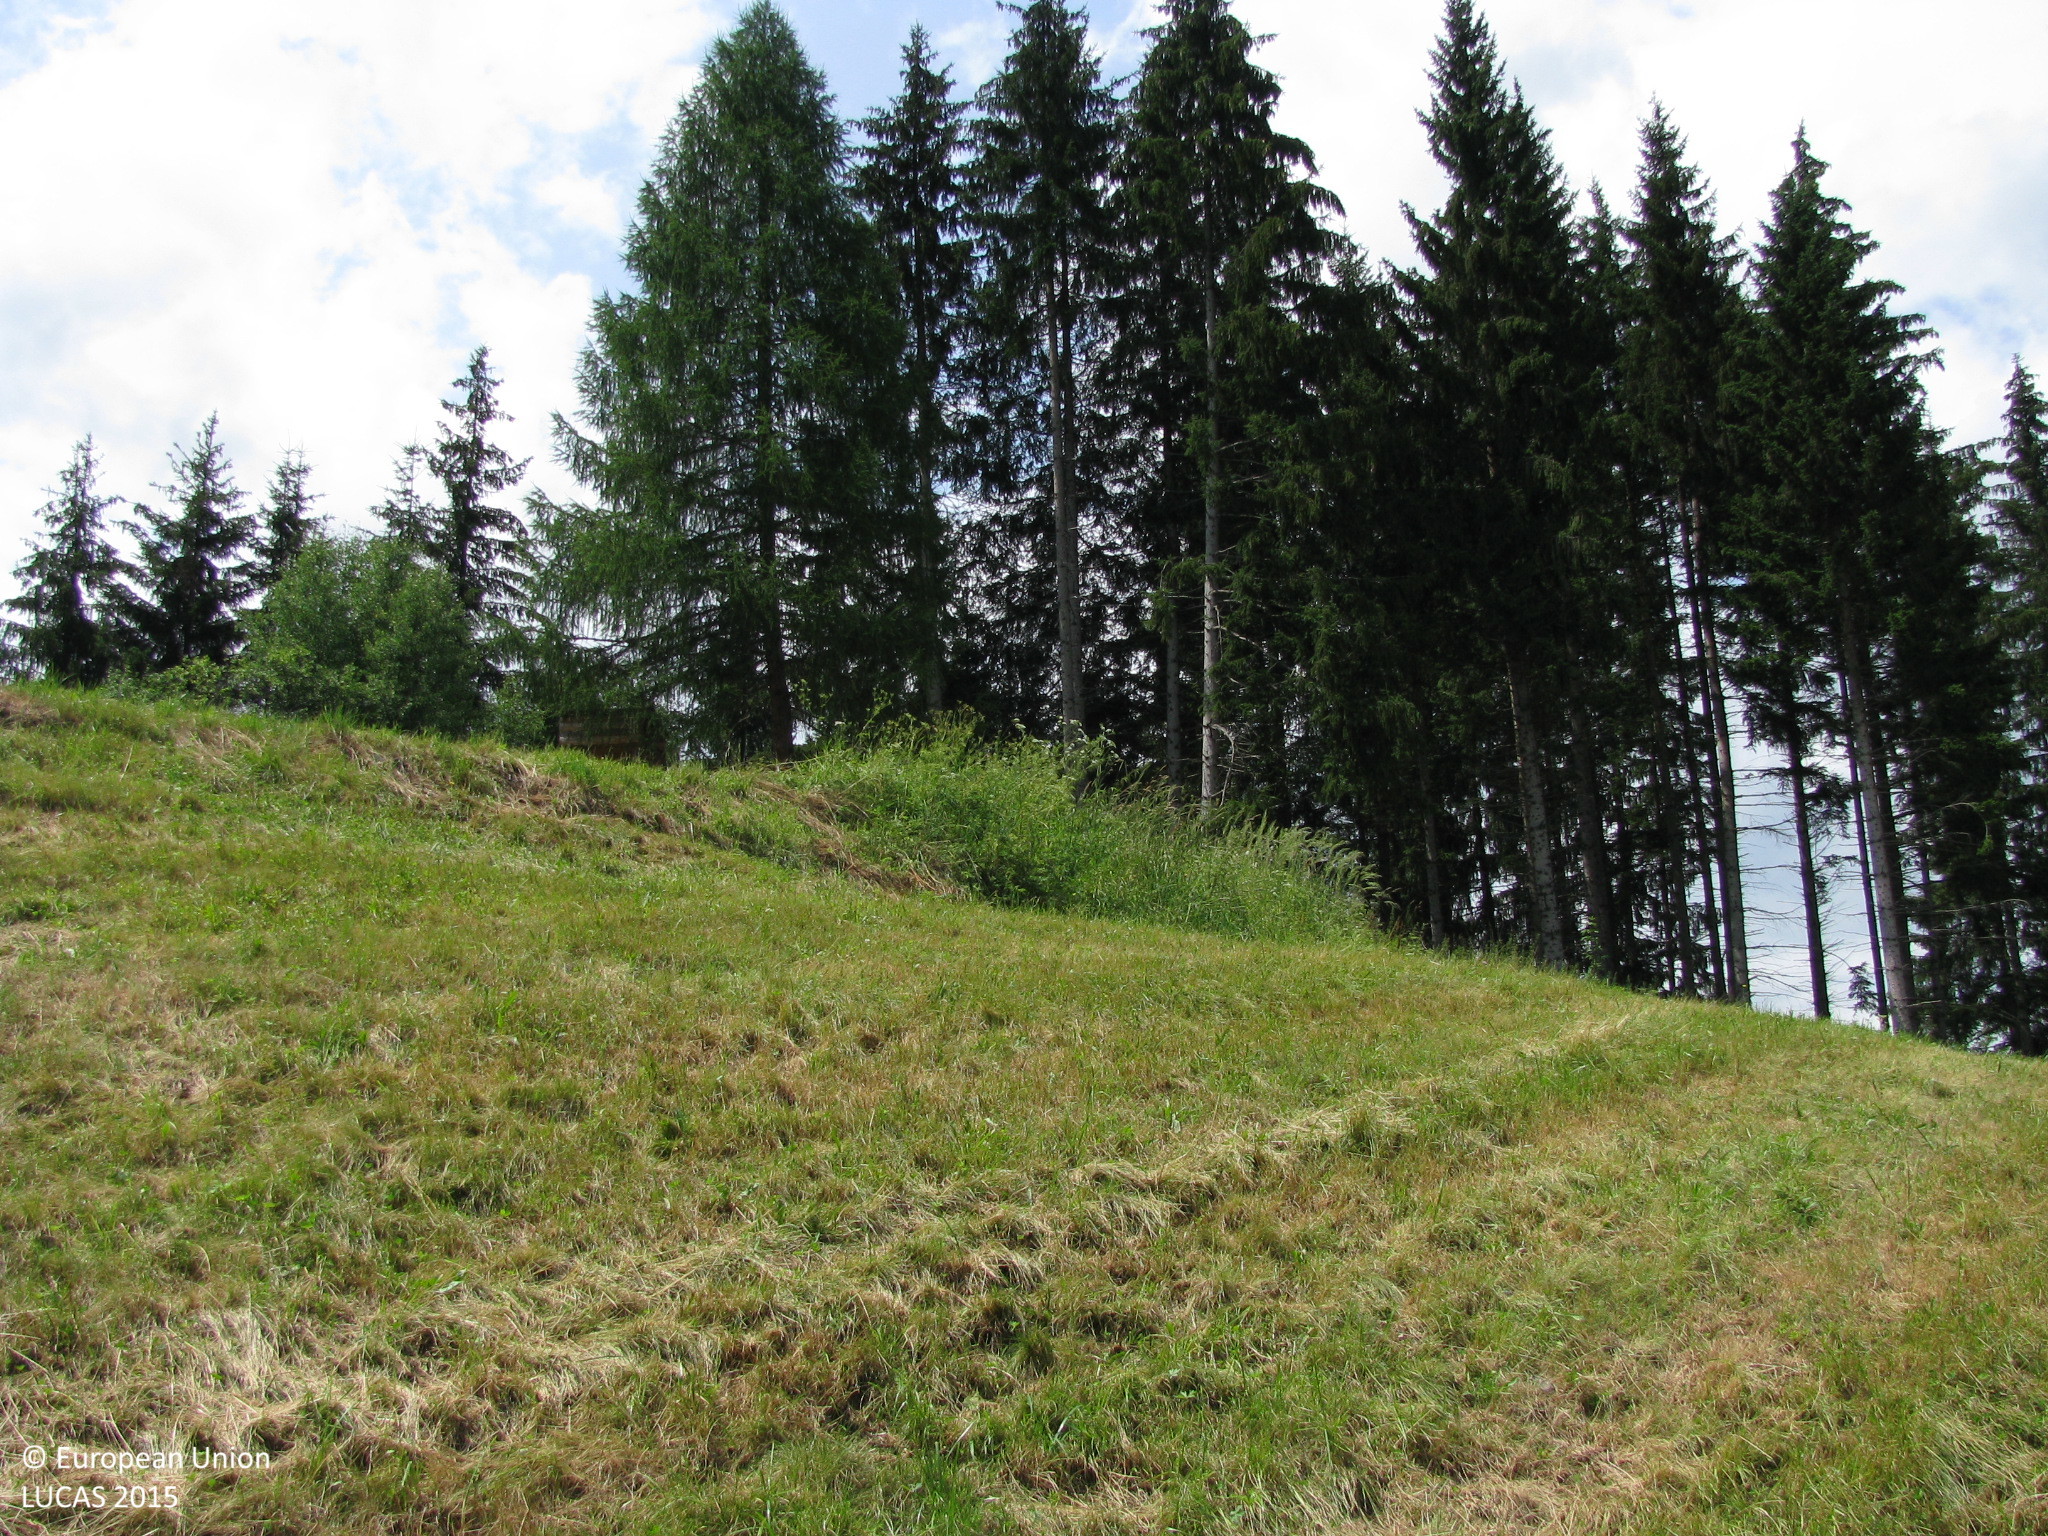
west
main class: Grassland
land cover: Grassland without tree/shrub cover
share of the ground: > 75 %
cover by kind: herbaceous plants 100 %
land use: Agriculture (excluding fallow land and kitchen gardens)
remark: Harvested field
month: July
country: AT
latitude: 47.1425
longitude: 14.8647
